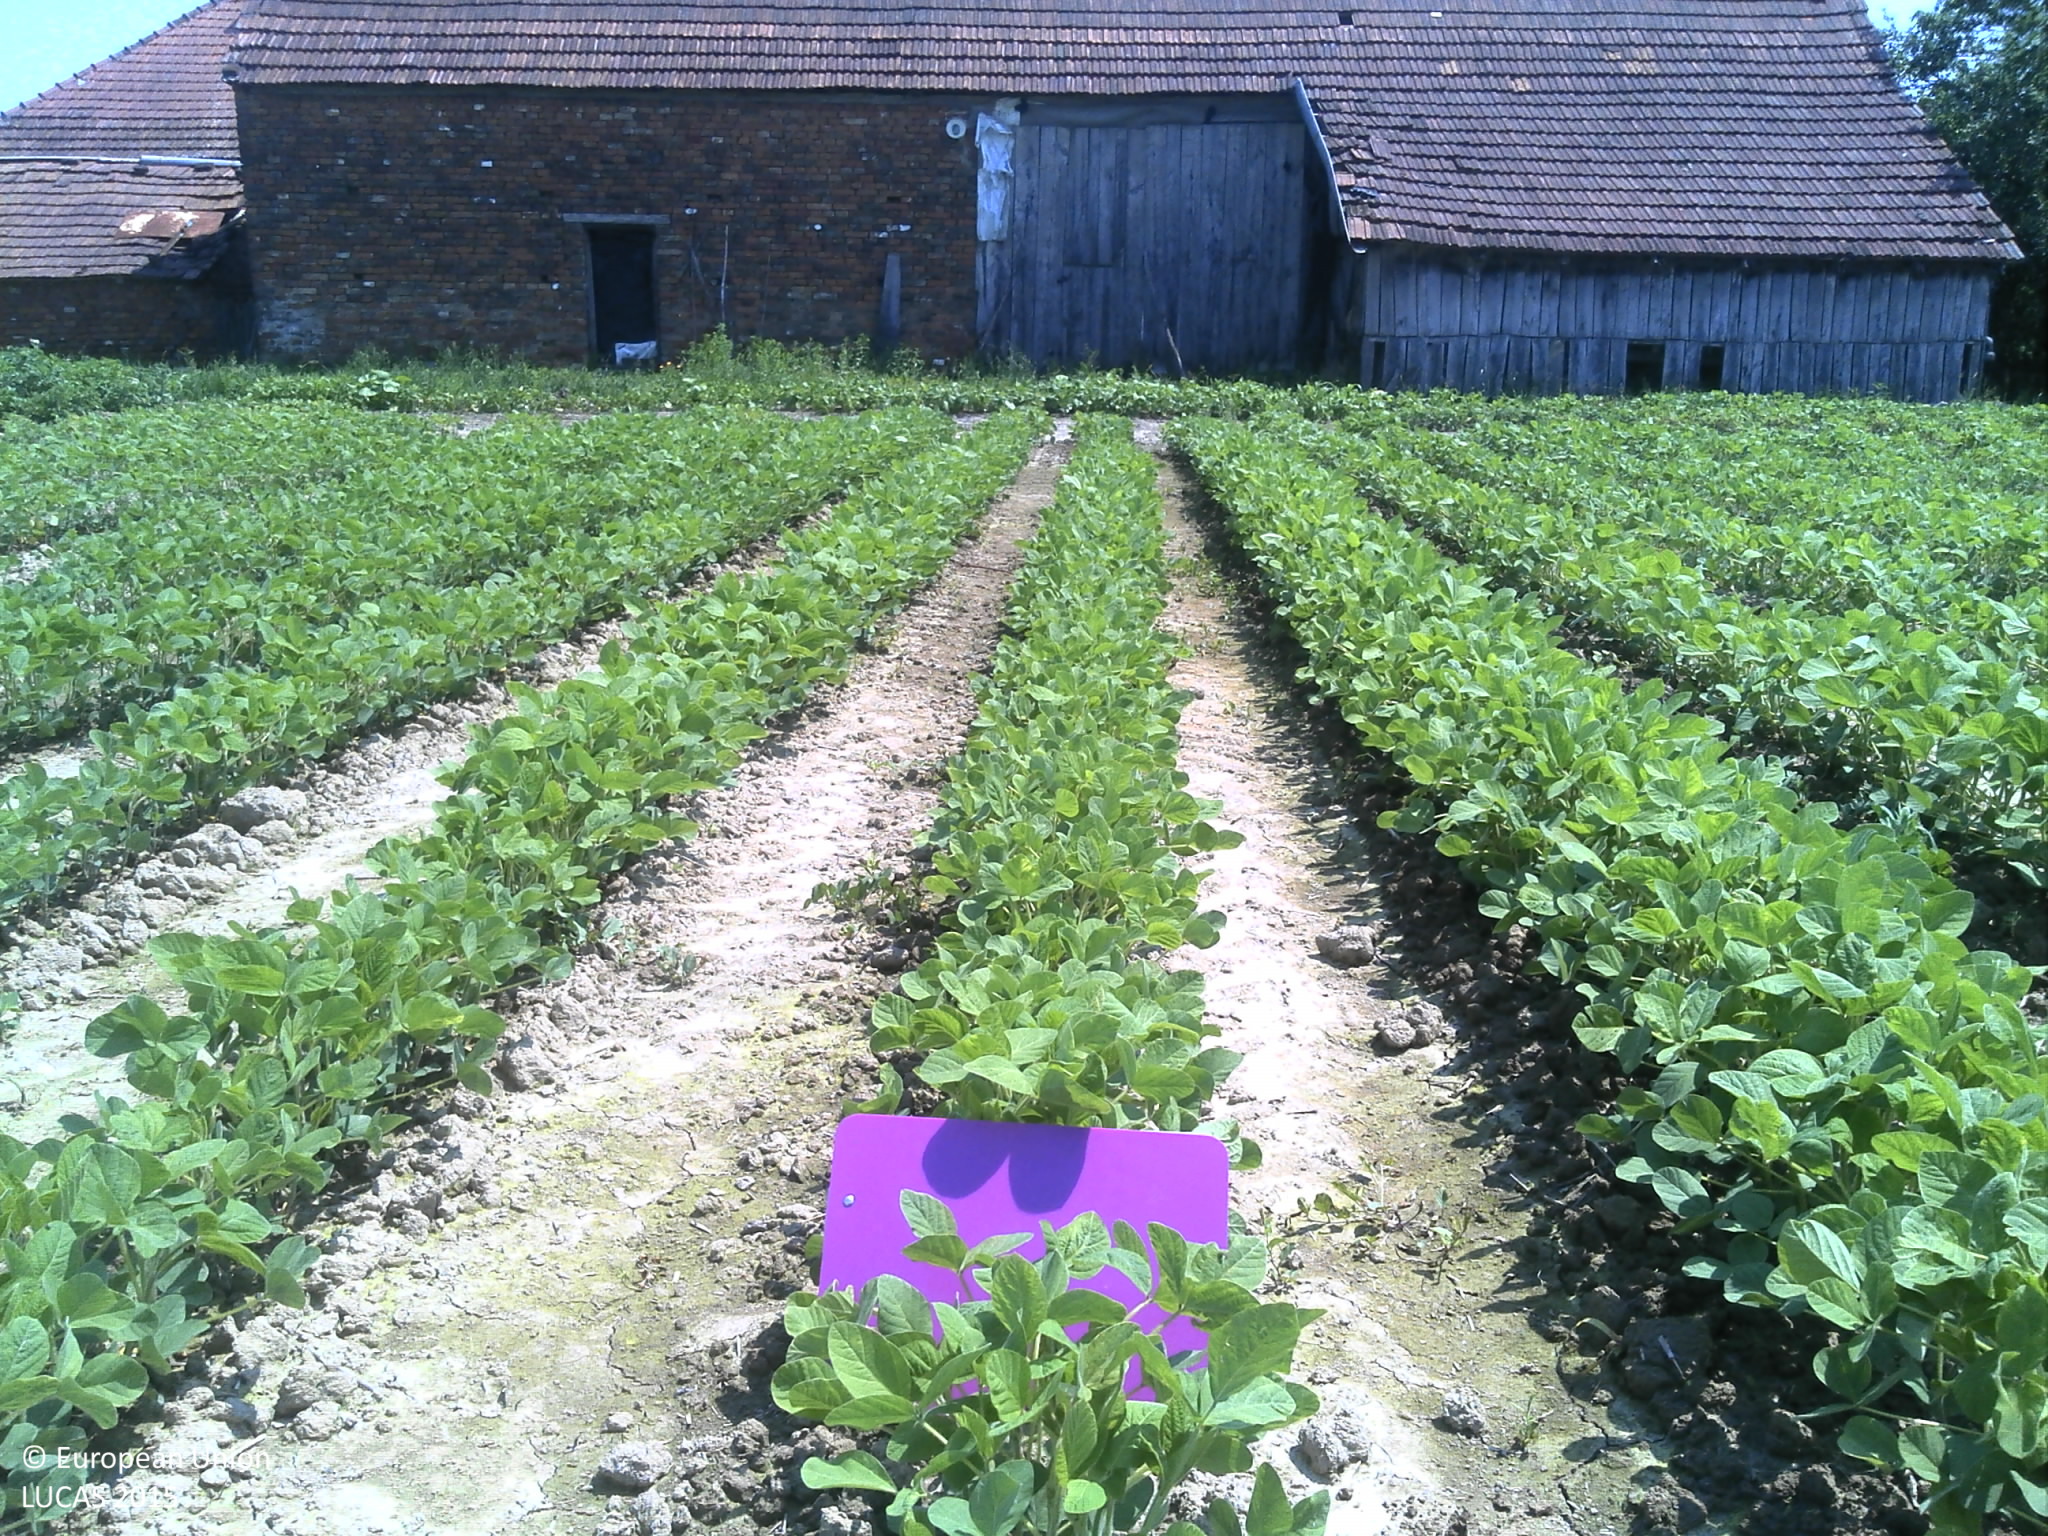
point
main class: Cropland
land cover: Soya
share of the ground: 10 - 25 %
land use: Agriculture (excluding fallow land and kitchen gardens)
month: June
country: HR
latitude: 45.6730
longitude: 17.9761
